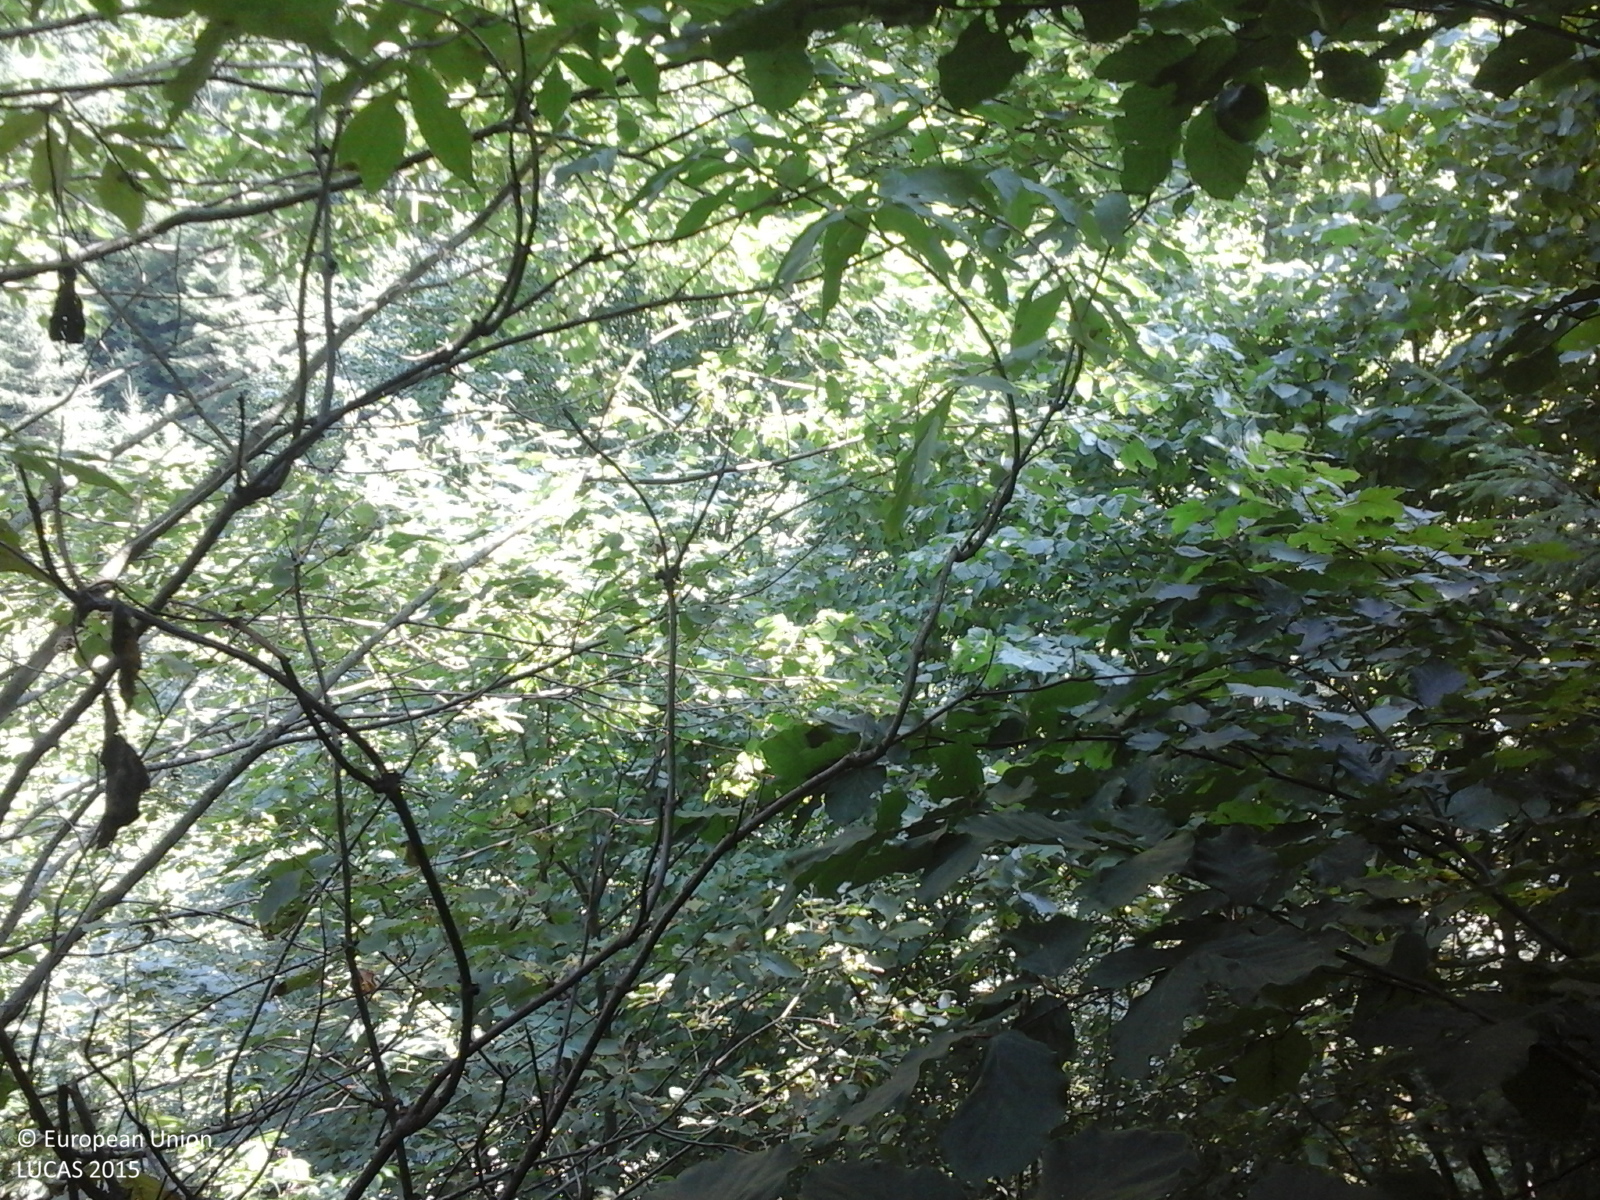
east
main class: Woodland
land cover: Other mixed woodland
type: beech forest
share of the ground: > 75 %
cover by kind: broadleaved forest trees 75 %, coniferous forest trees 25 %
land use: Forestry
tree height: > 5 m
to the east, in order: Other mixed woodland; Grassland with sparse tree/shrub cover; Pine dominated coniferous woodland; Other mixed woodland; Tracks; Other mixed woodland
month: September
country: RO
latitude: 47.8556
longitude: 24.5447
